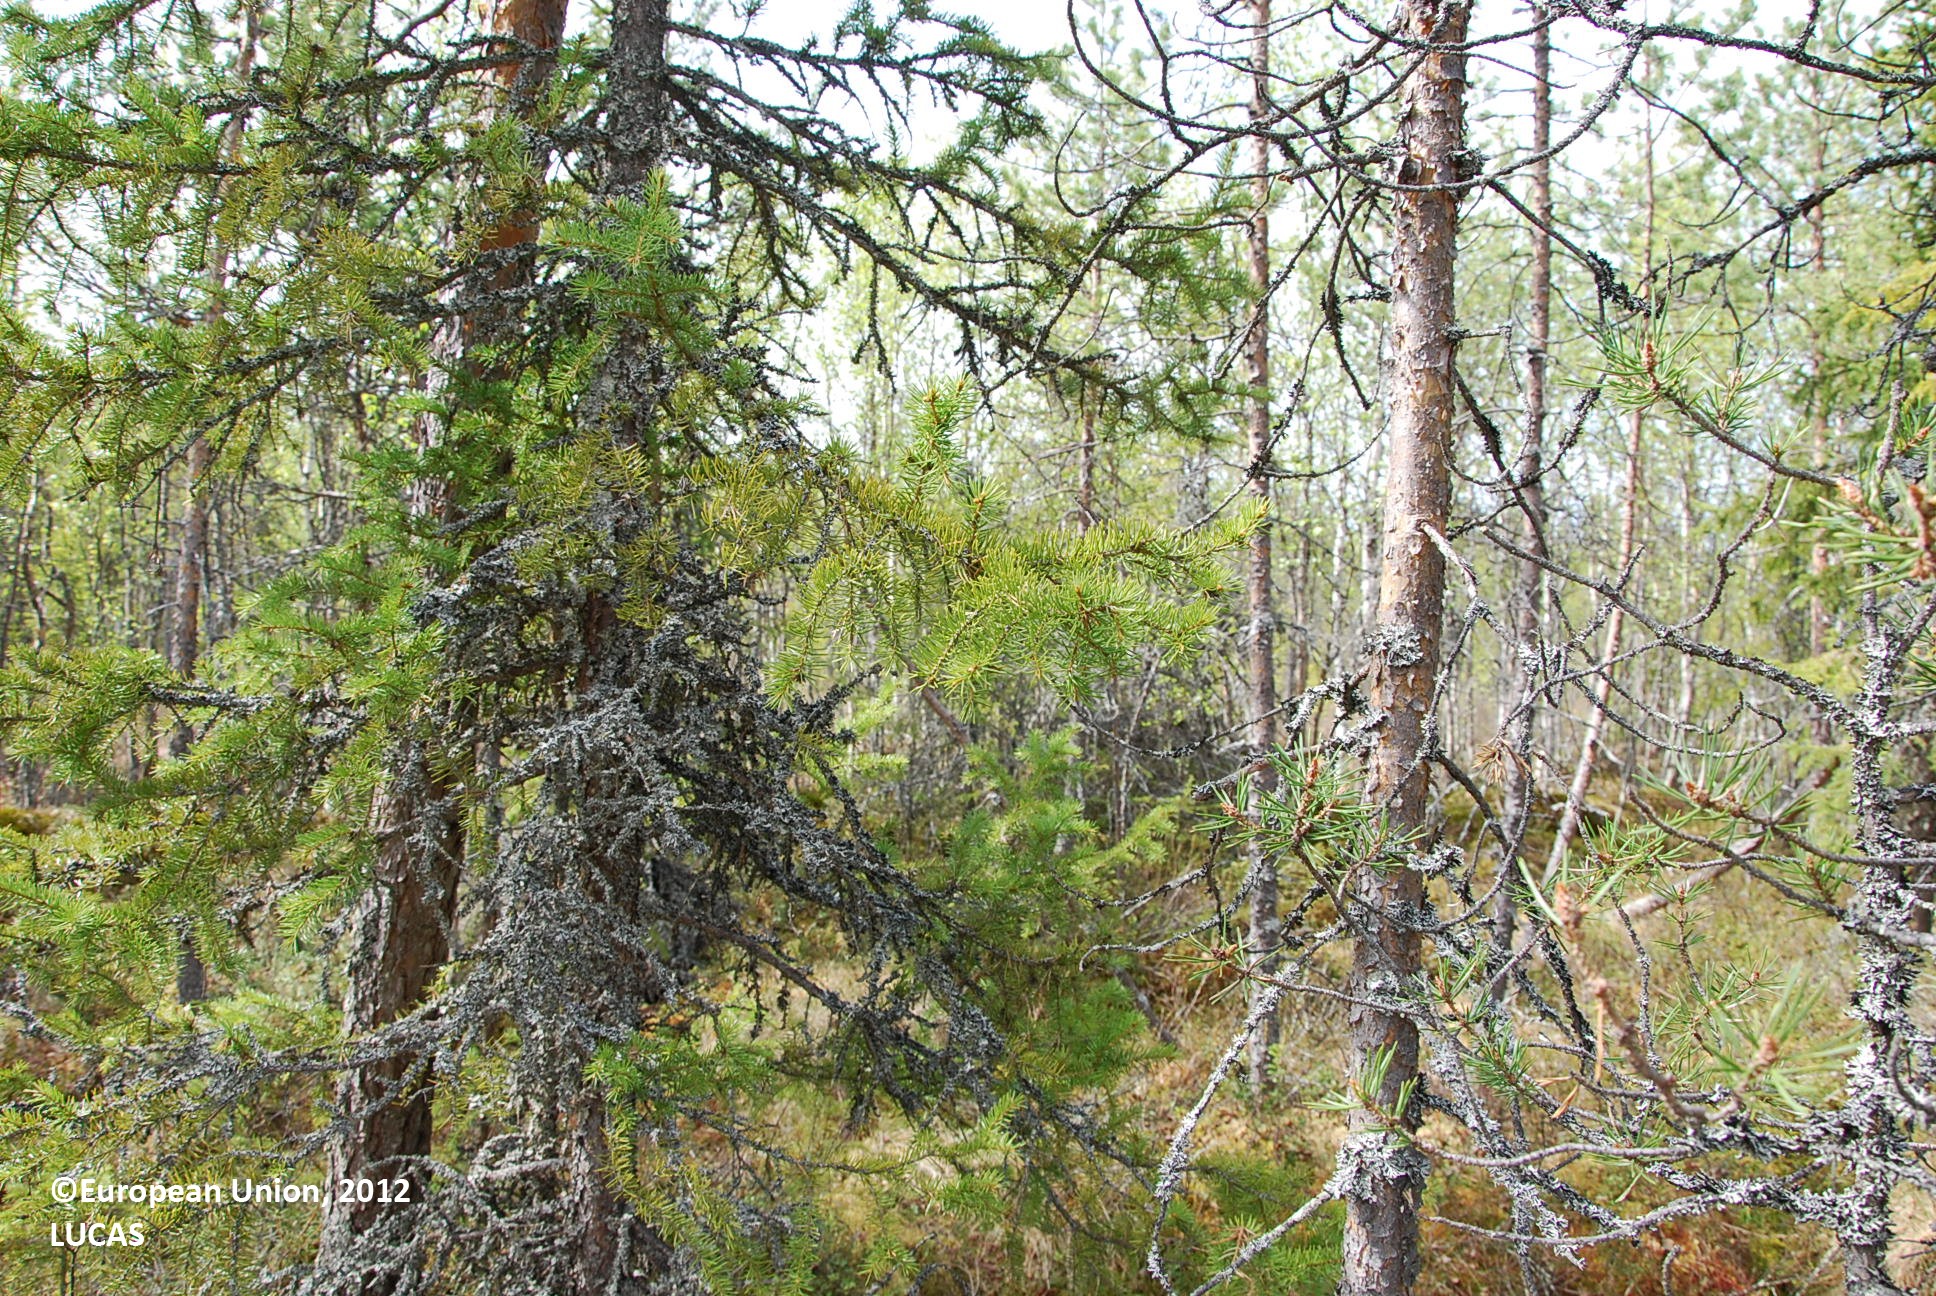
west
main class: Woodland
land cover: Pine dominated coniferous woodland
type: boreal forest
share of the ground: > 75 %
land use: Forestry
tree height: > 5 m
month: June
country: FI
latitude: 66.5791
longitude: 28.0536
